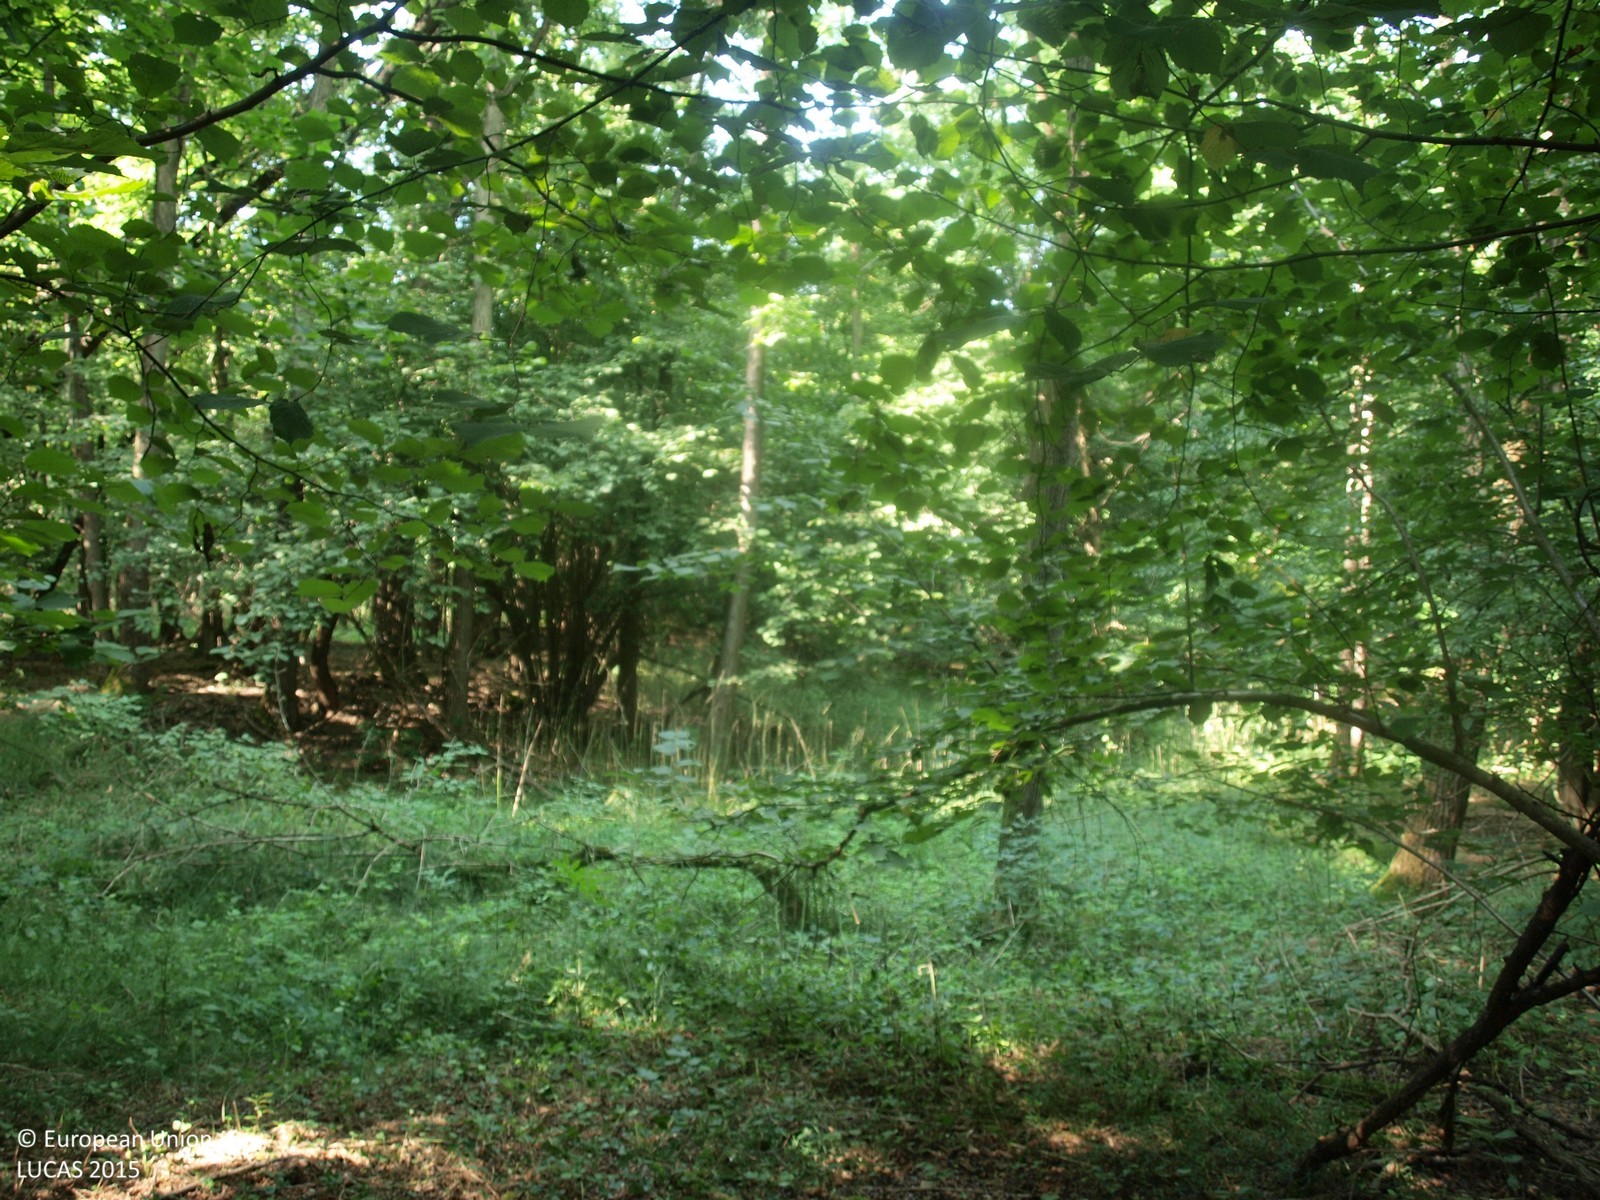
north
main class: Woodland
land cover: Broadleaved woodland
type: mesophytic deciduous forest
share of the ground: > 75 %
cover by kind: broadleaved forest trees 100 %
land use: Forestry
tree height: > 5 m
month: August
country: HR
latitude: 45.9621
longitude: 16.6713
